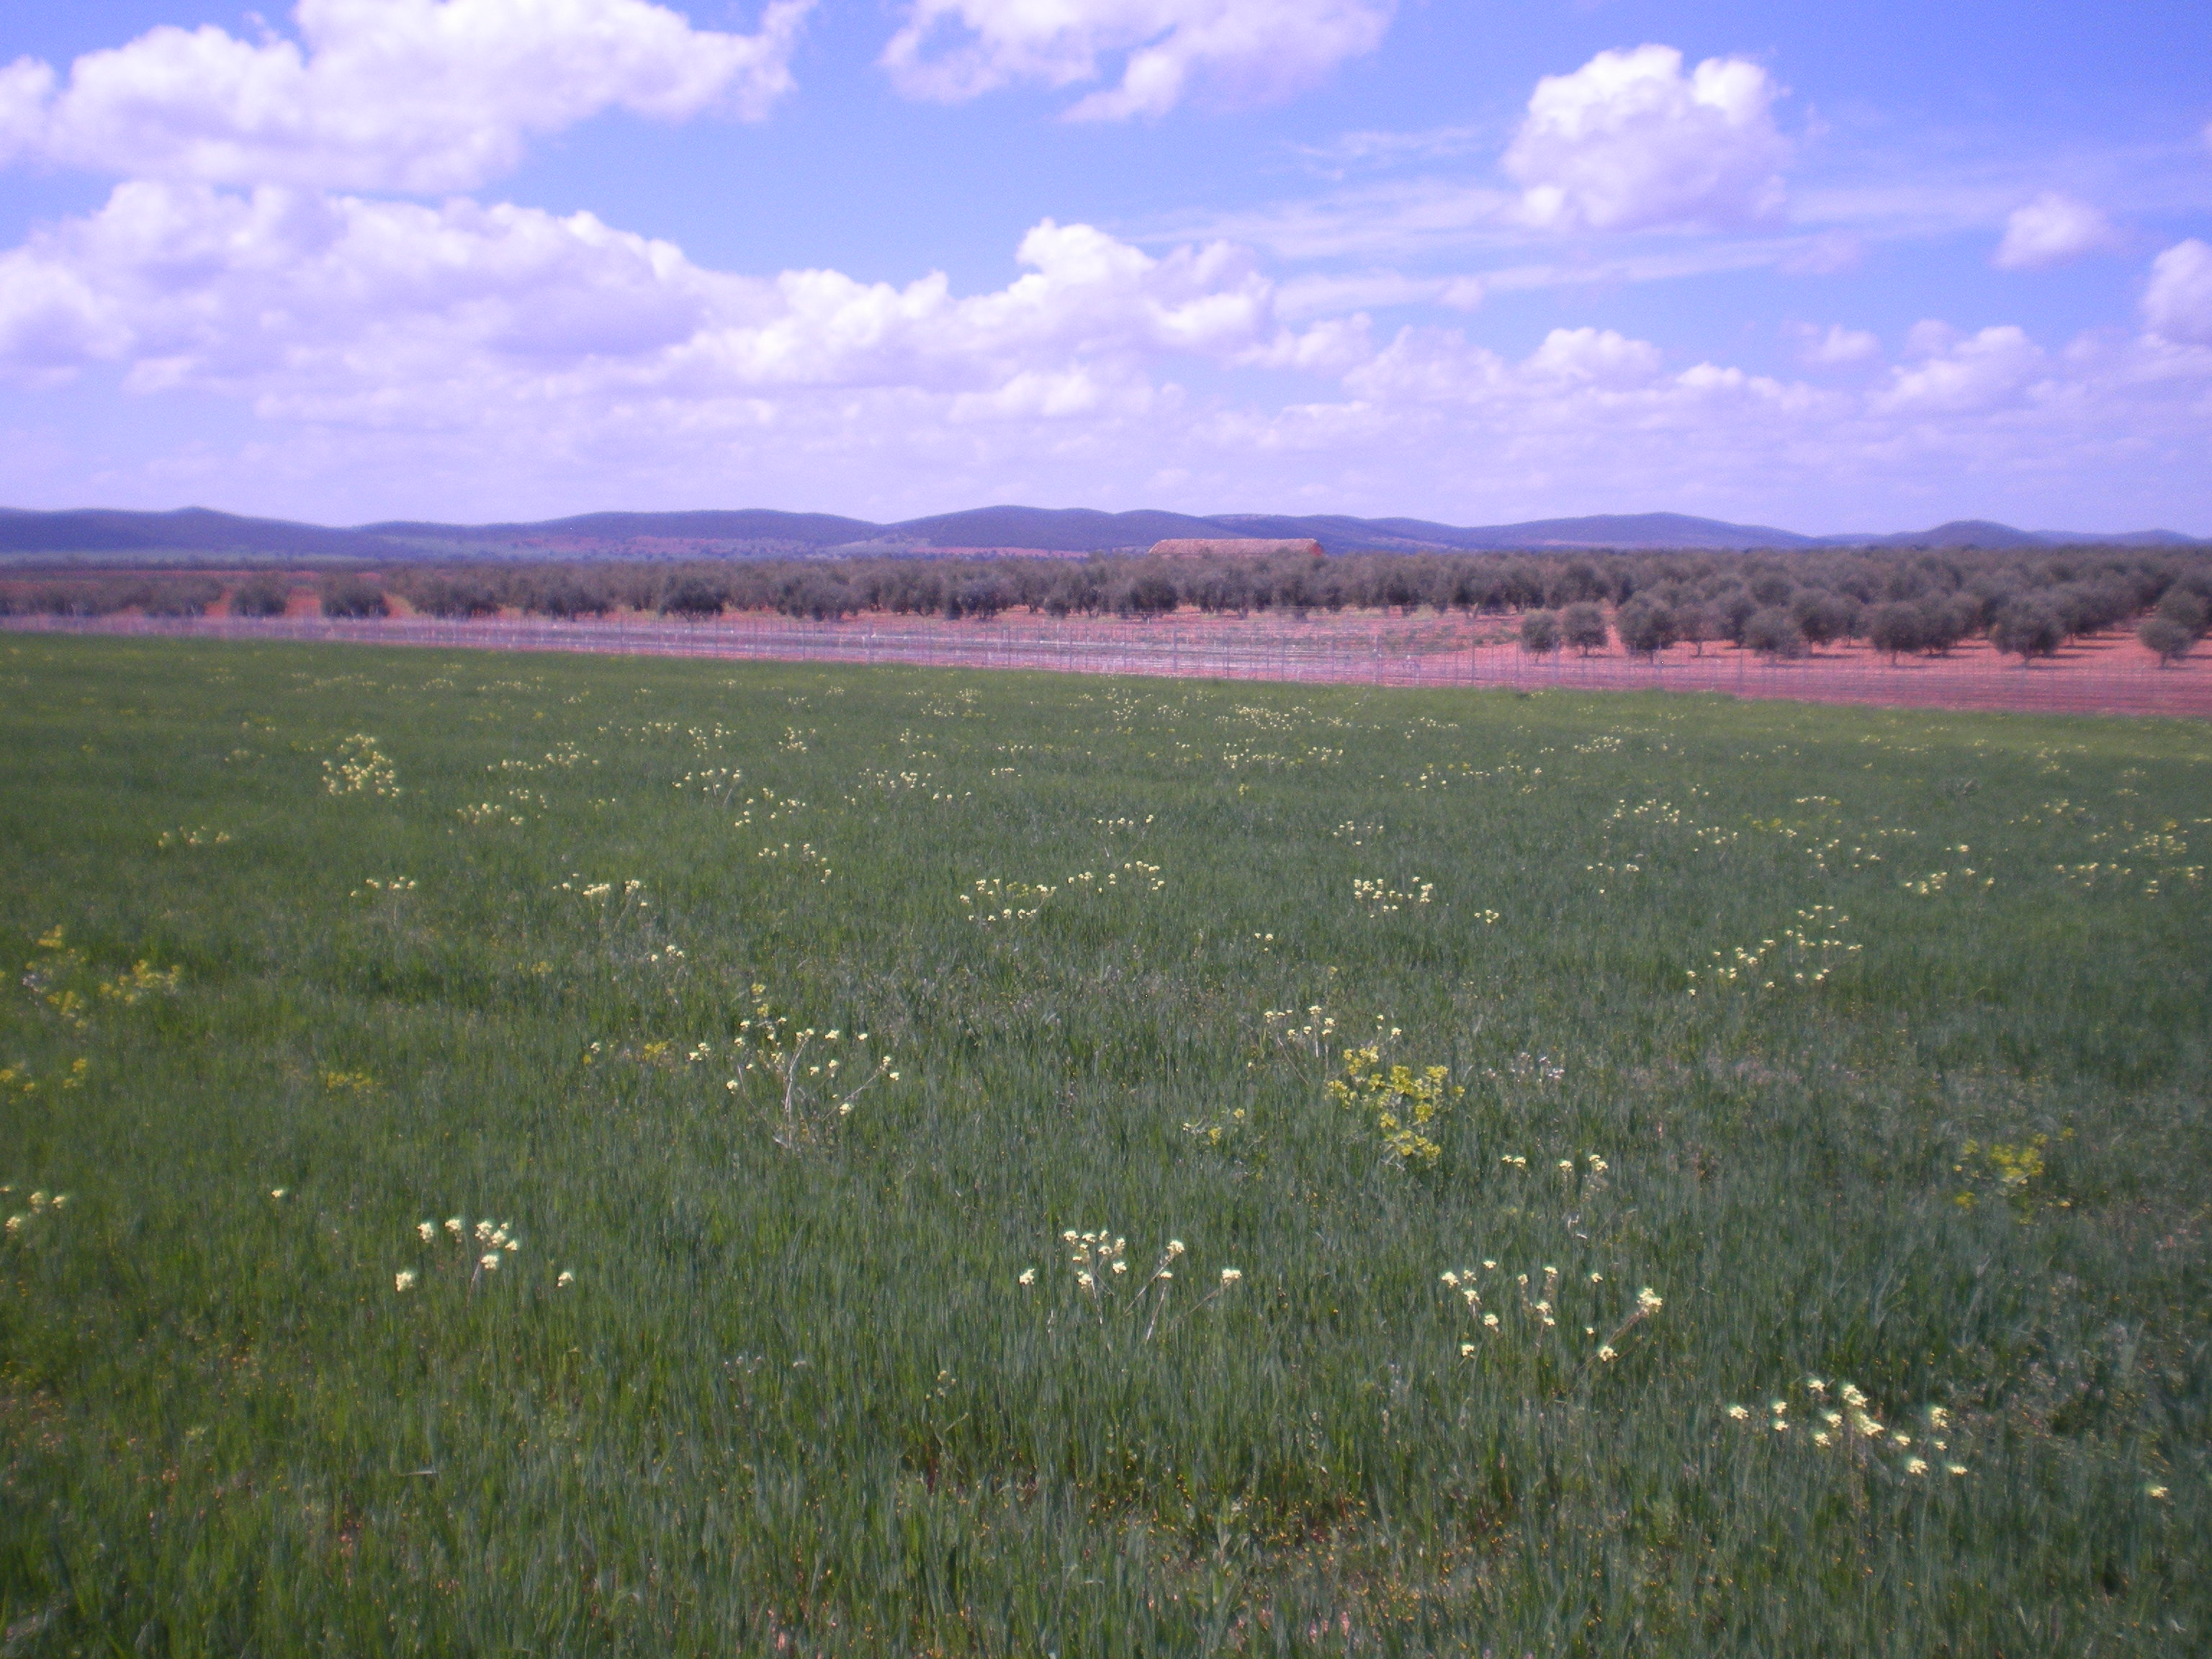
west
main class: Cropland
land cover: Oats
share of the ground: > 75 %
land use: Agriculture (excluding fallow land and kitchen gardens)
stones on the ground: 25 - 50 %
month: April
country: ES
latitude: 38.7033
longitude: -3.5227
